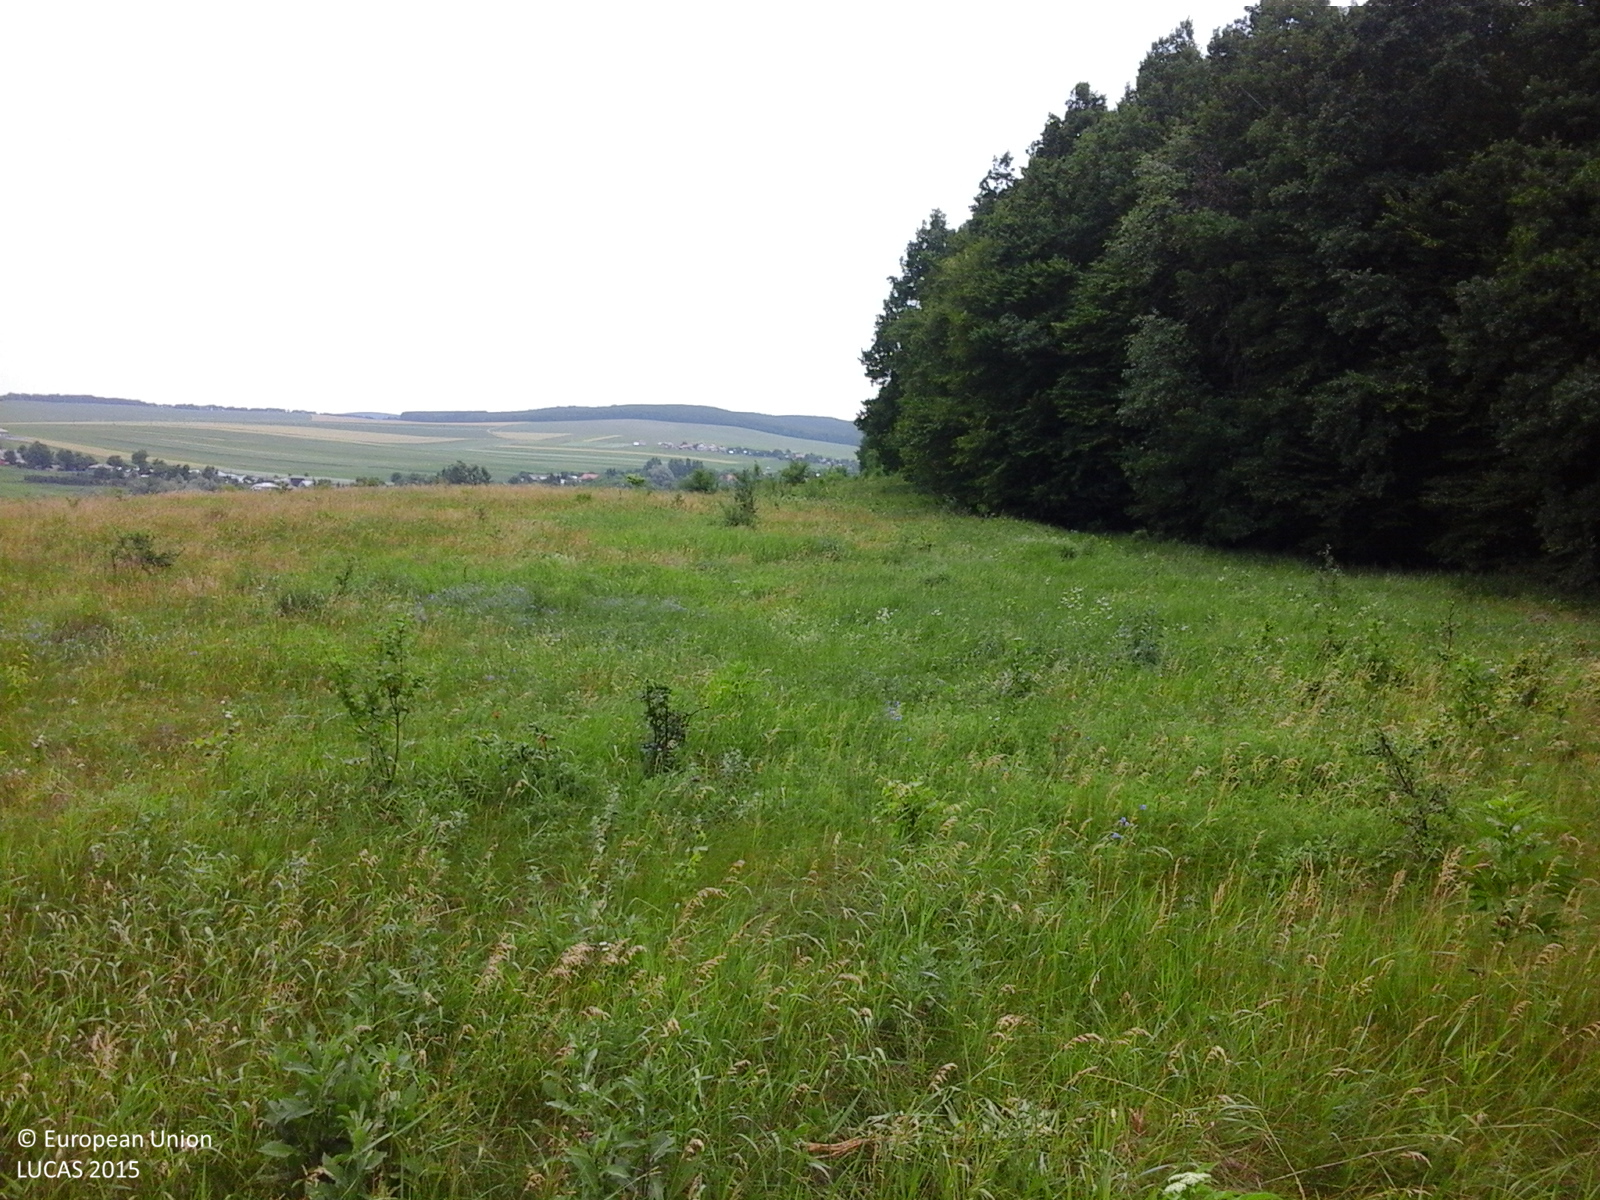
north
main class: Grassland
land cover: Grassland without tree/shrub cover
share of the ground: > 75 %
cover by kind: herbaceous plants 100 %
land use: Agriculture (excluding fallow land and kitchen gardens)
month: June
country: RO
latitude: 47.2054
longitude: 26.6323
